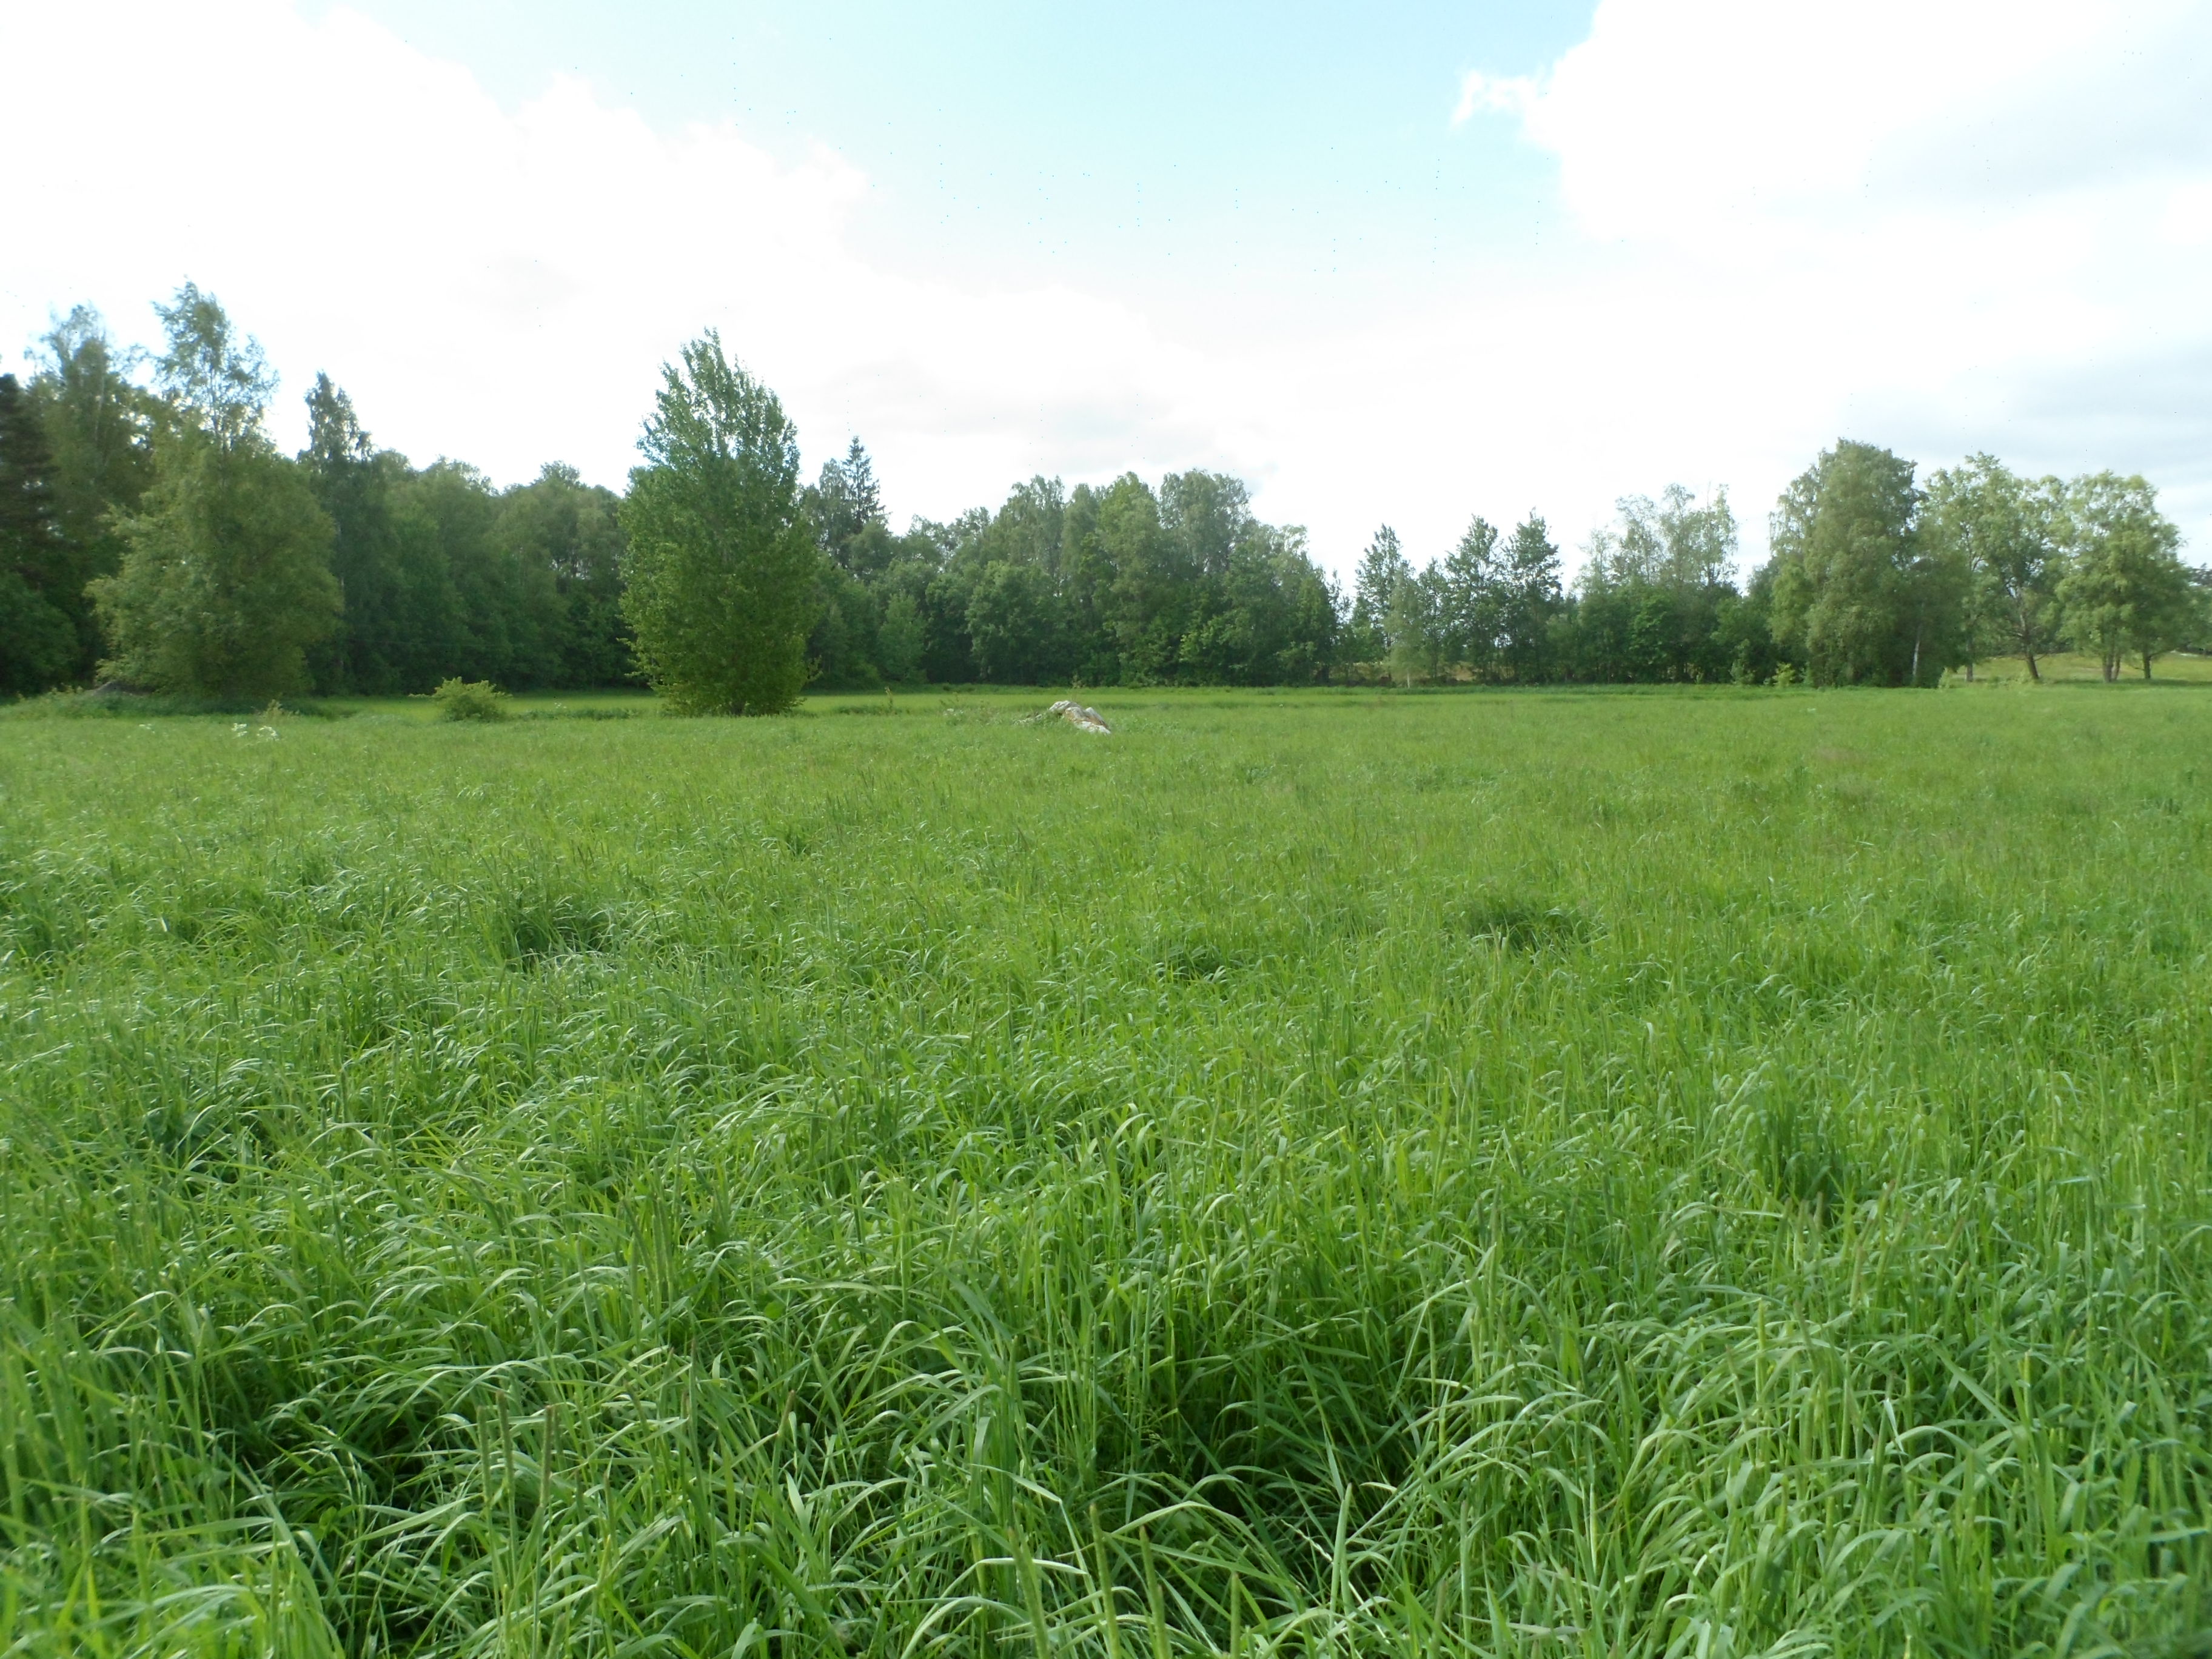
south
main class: Grassland
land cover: Grassland without tree/shrub cover
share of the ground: > 75 %
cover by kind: herbaceous plants 100 %
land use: Agriculture (excluding fallow land and kitchen gardens)
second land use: Amenities, museums, leisure
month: June
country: SE
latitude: 56.8604
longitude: 14.6386
